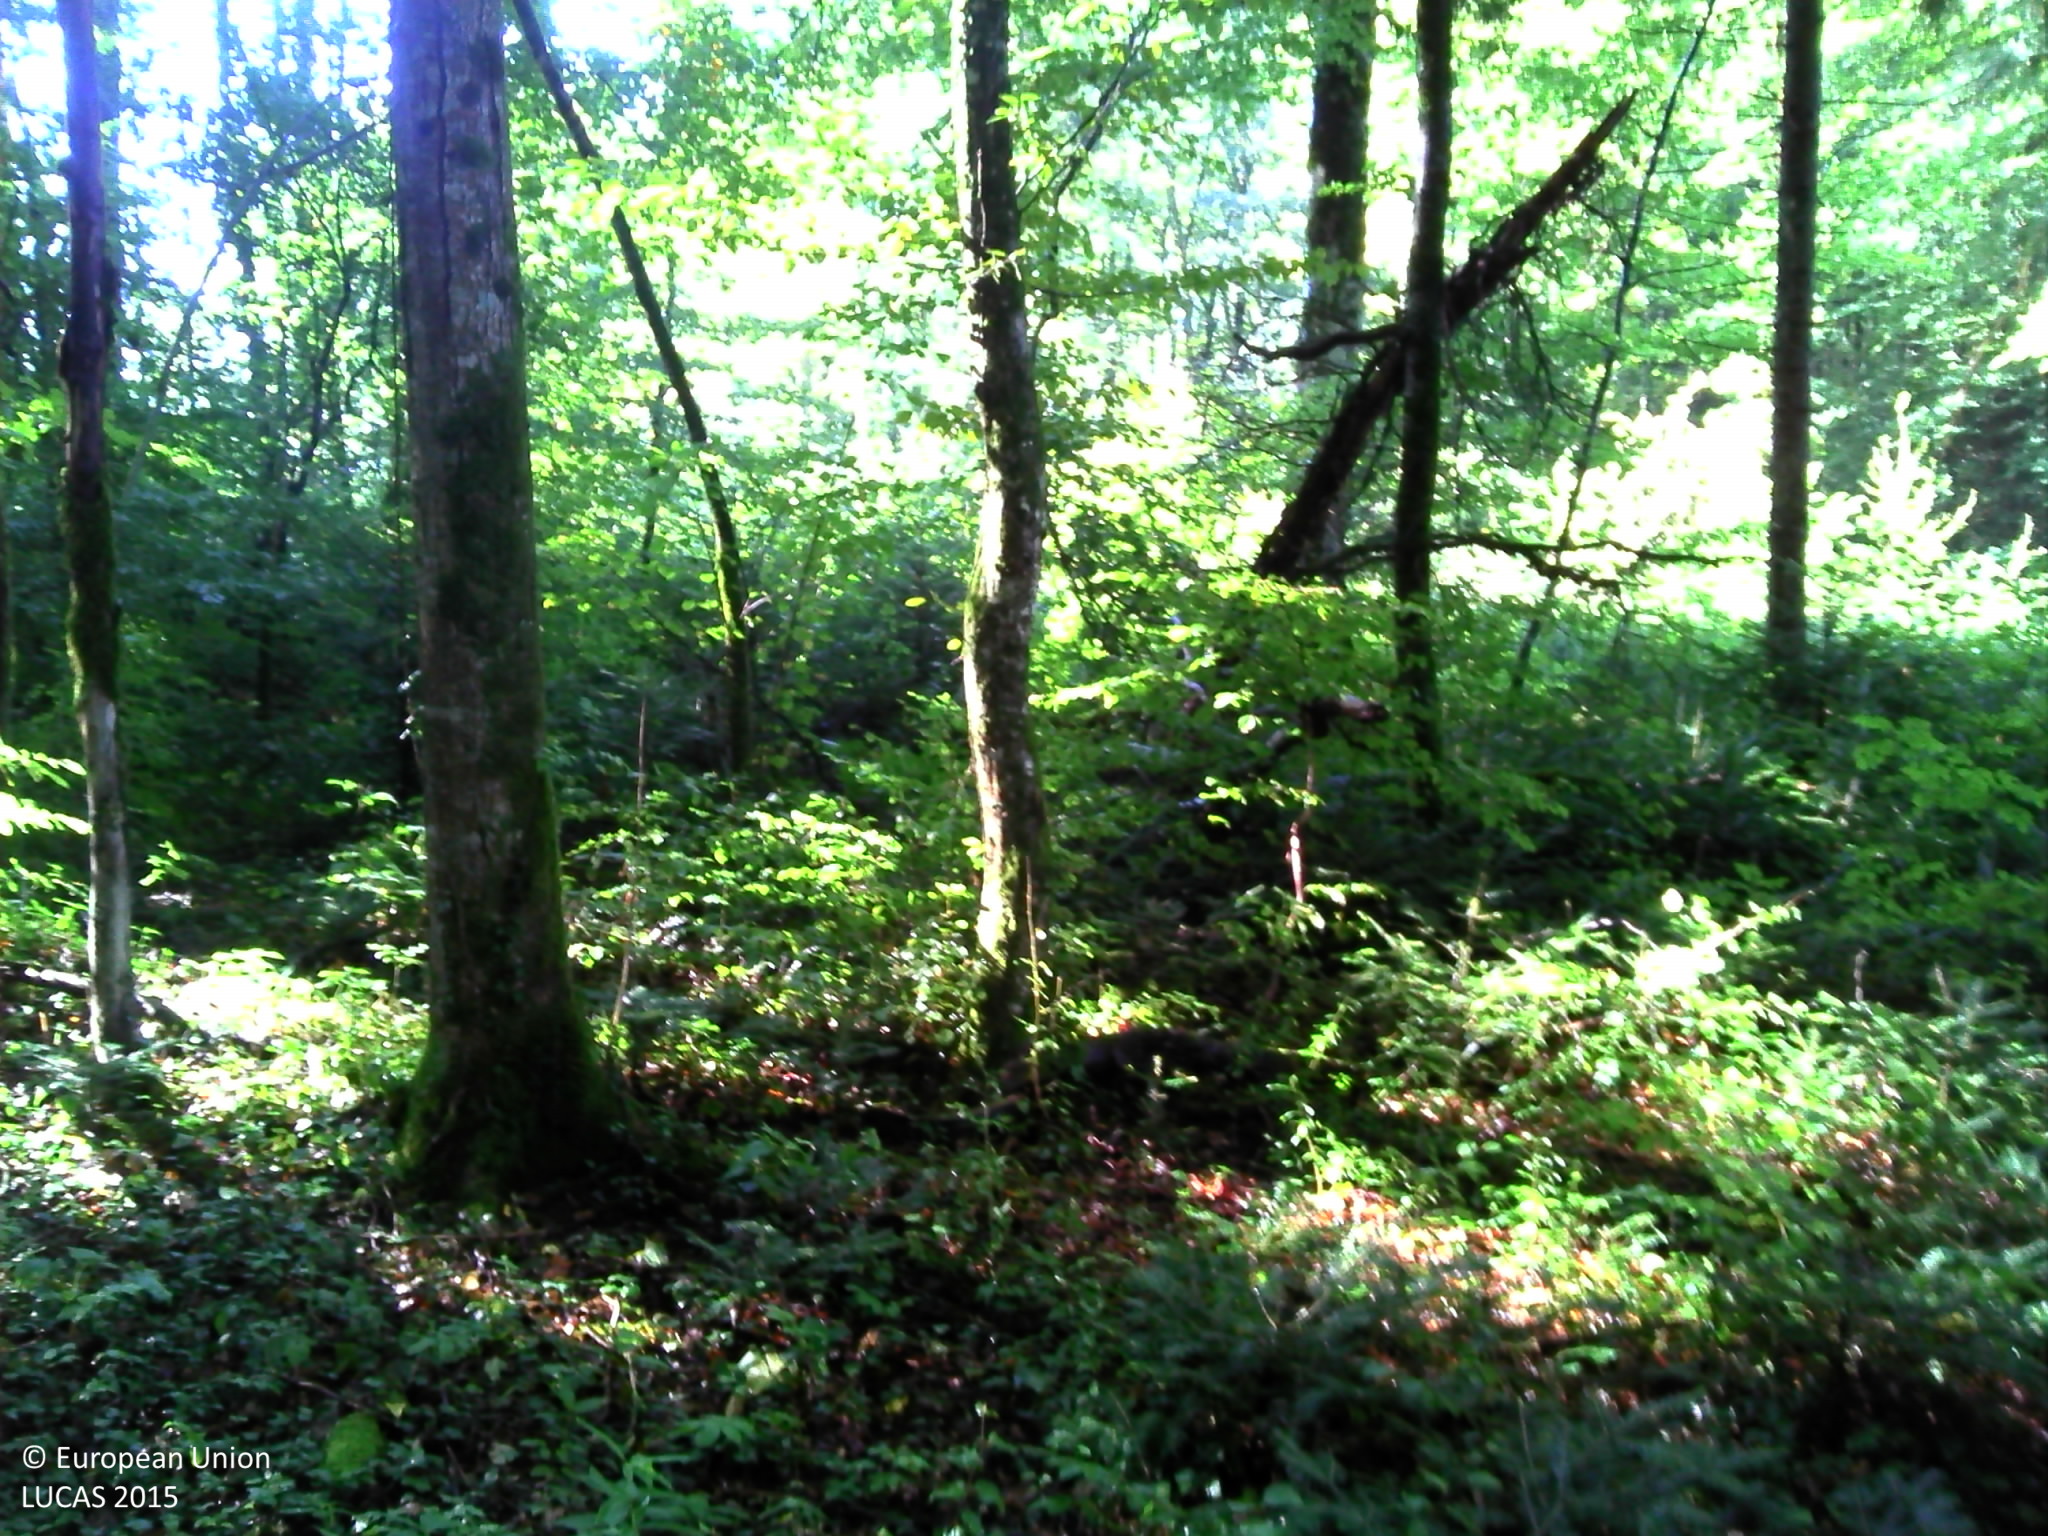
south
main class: Woodland
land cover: Broadleaved woodland
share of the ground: > 75 %
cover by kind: broadleaved forest trees 85 %, coniferous forest trees 5 %, herbaceous plants 5 %, unconsolidated bare surface 5 %
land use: Forestry
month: September
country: FR
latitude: 47.0975
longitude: 6.2735
